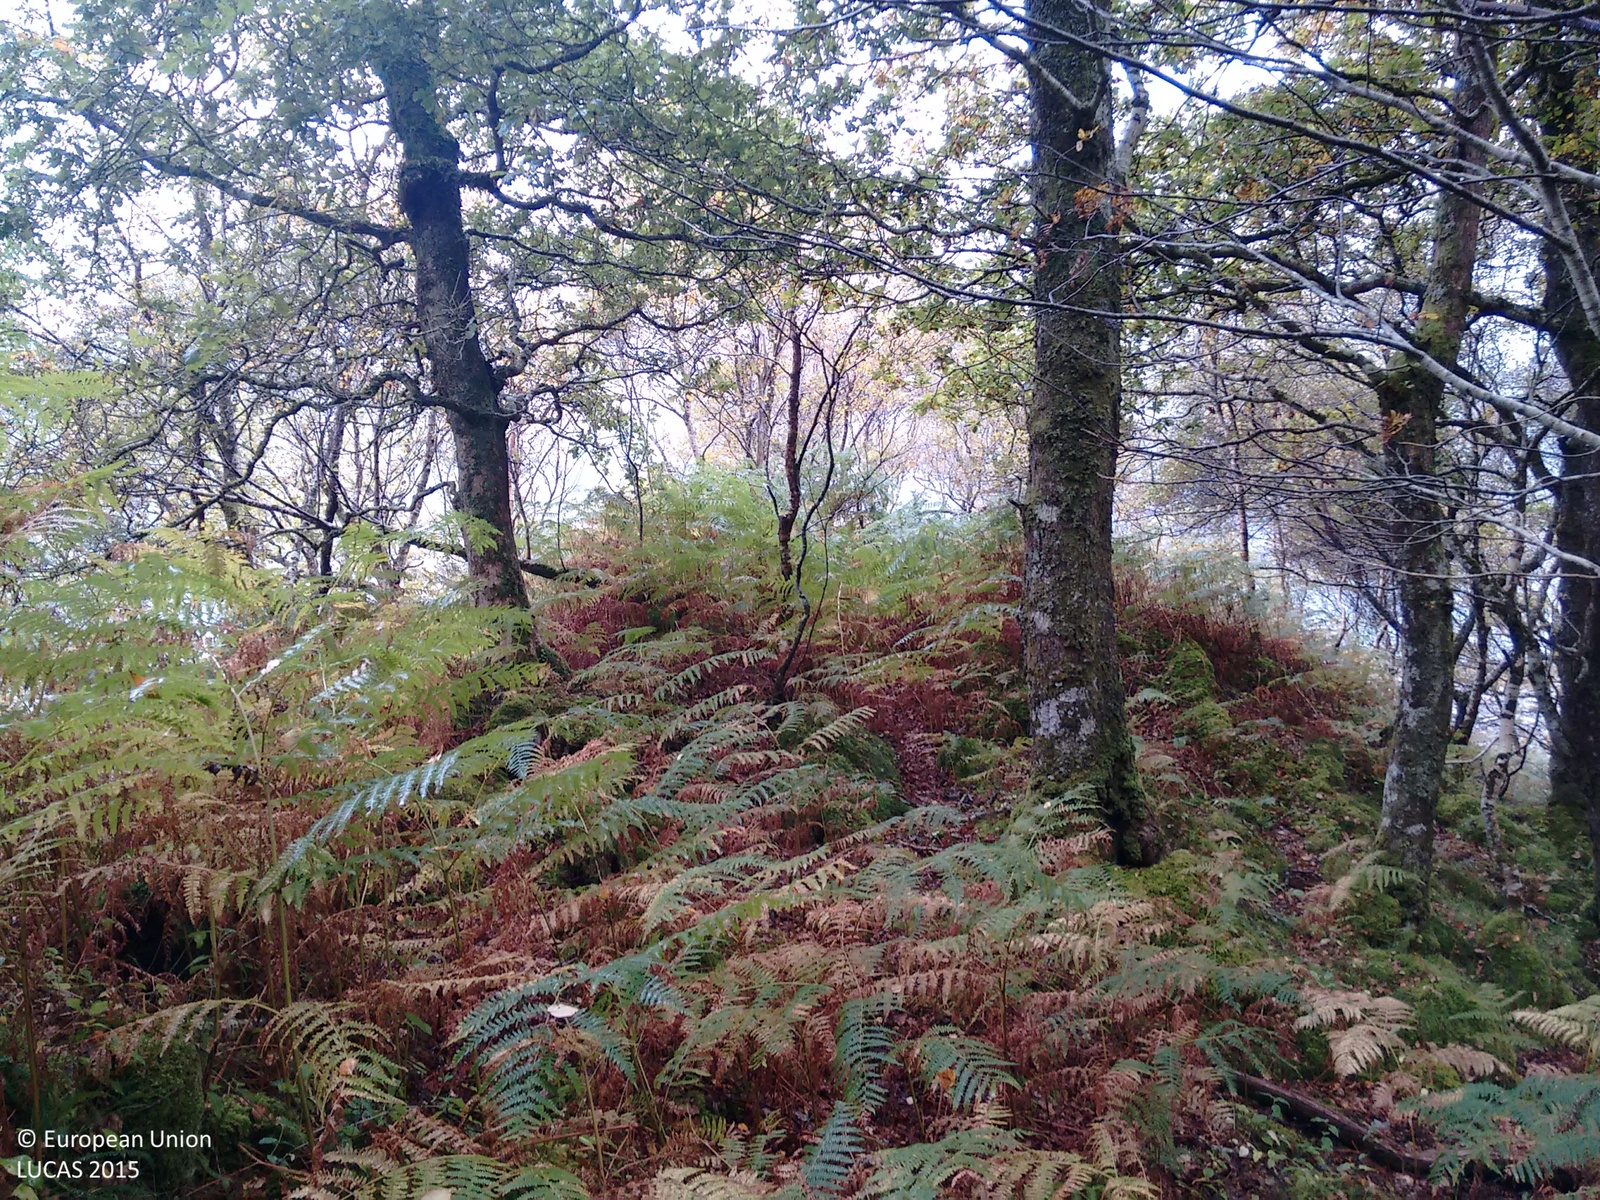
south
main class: Woodland
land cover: Broadleaved woodland
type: acidophilous oak and oak-birch forest
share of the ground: > 75 %
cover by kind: broadleaved forest trees 80 %, shrubs 10 %, herbaceous plants 10 %
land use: Forestry
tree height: > 5 m
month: October
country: GB
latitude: 56.6856
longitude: -5.8161
